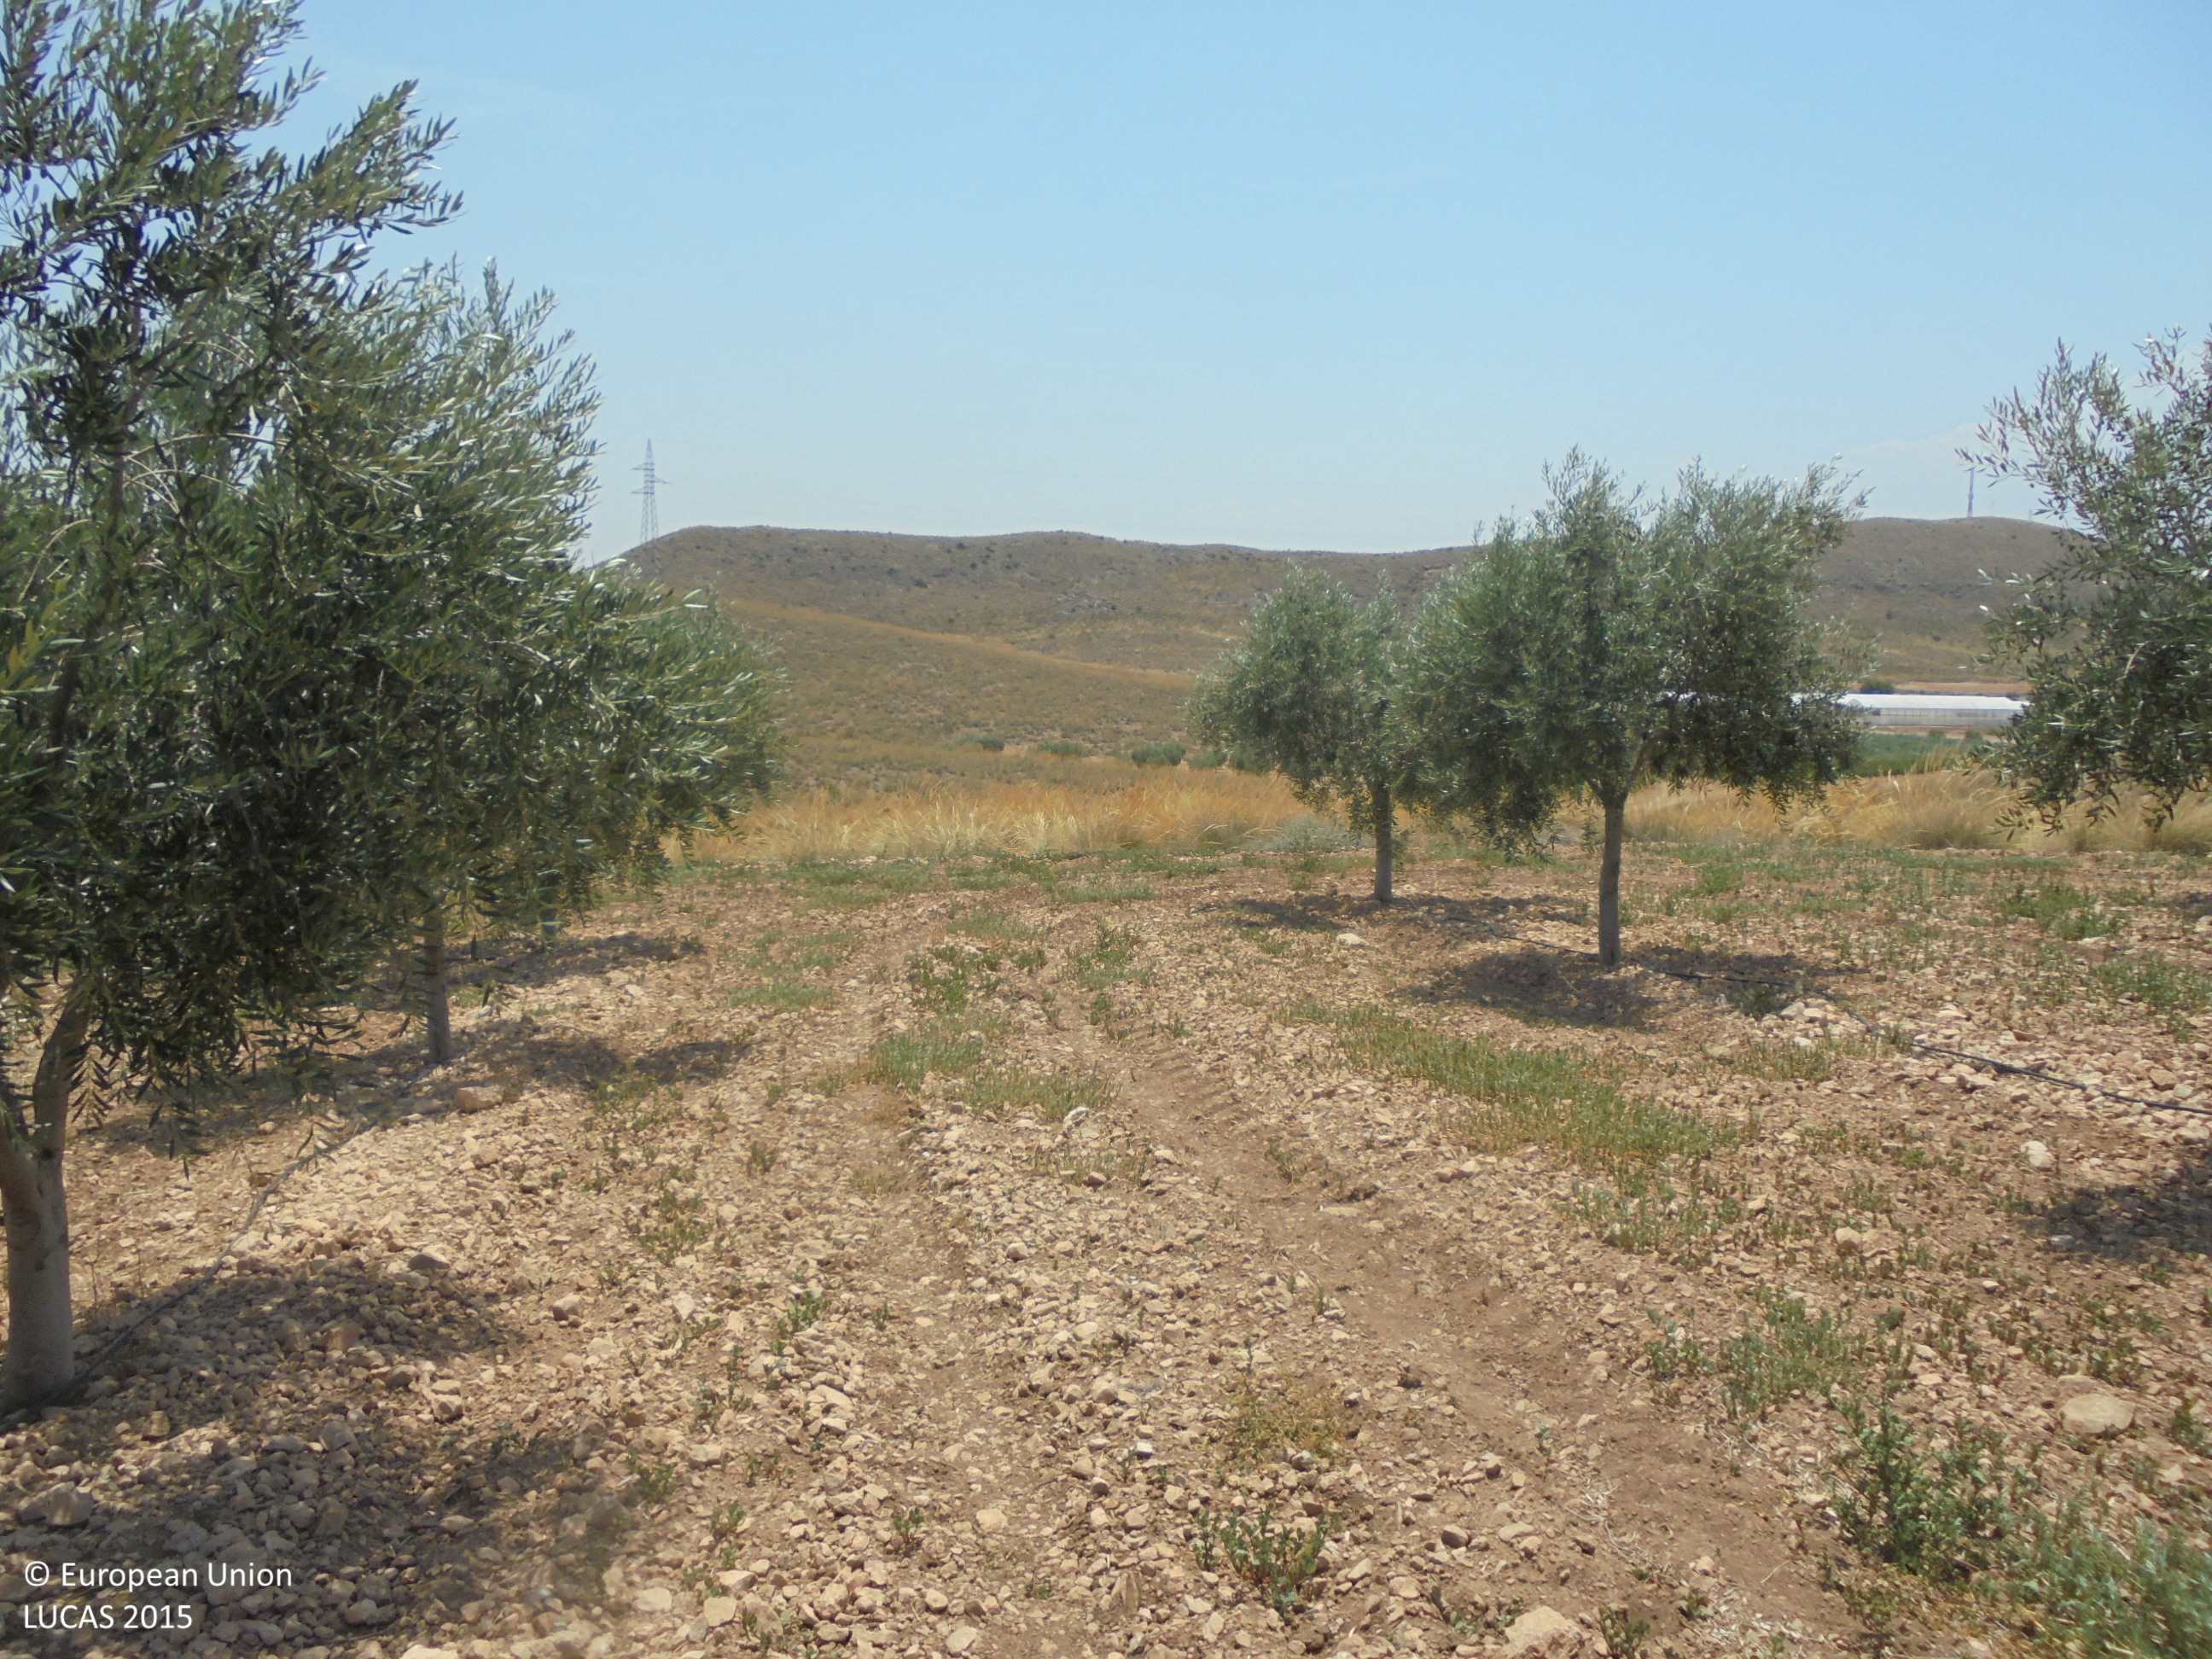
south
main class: Cropland
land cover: Olive groves
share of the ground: 25 - 50 %
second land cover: Spontaneously vegetated surfaces
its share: 50 - 75 %
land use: Agriculture (excluding fallow land and kitchen gardens)
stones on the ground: > 50 %
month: July
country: ES
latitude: 38.5253
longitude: -1.6818
